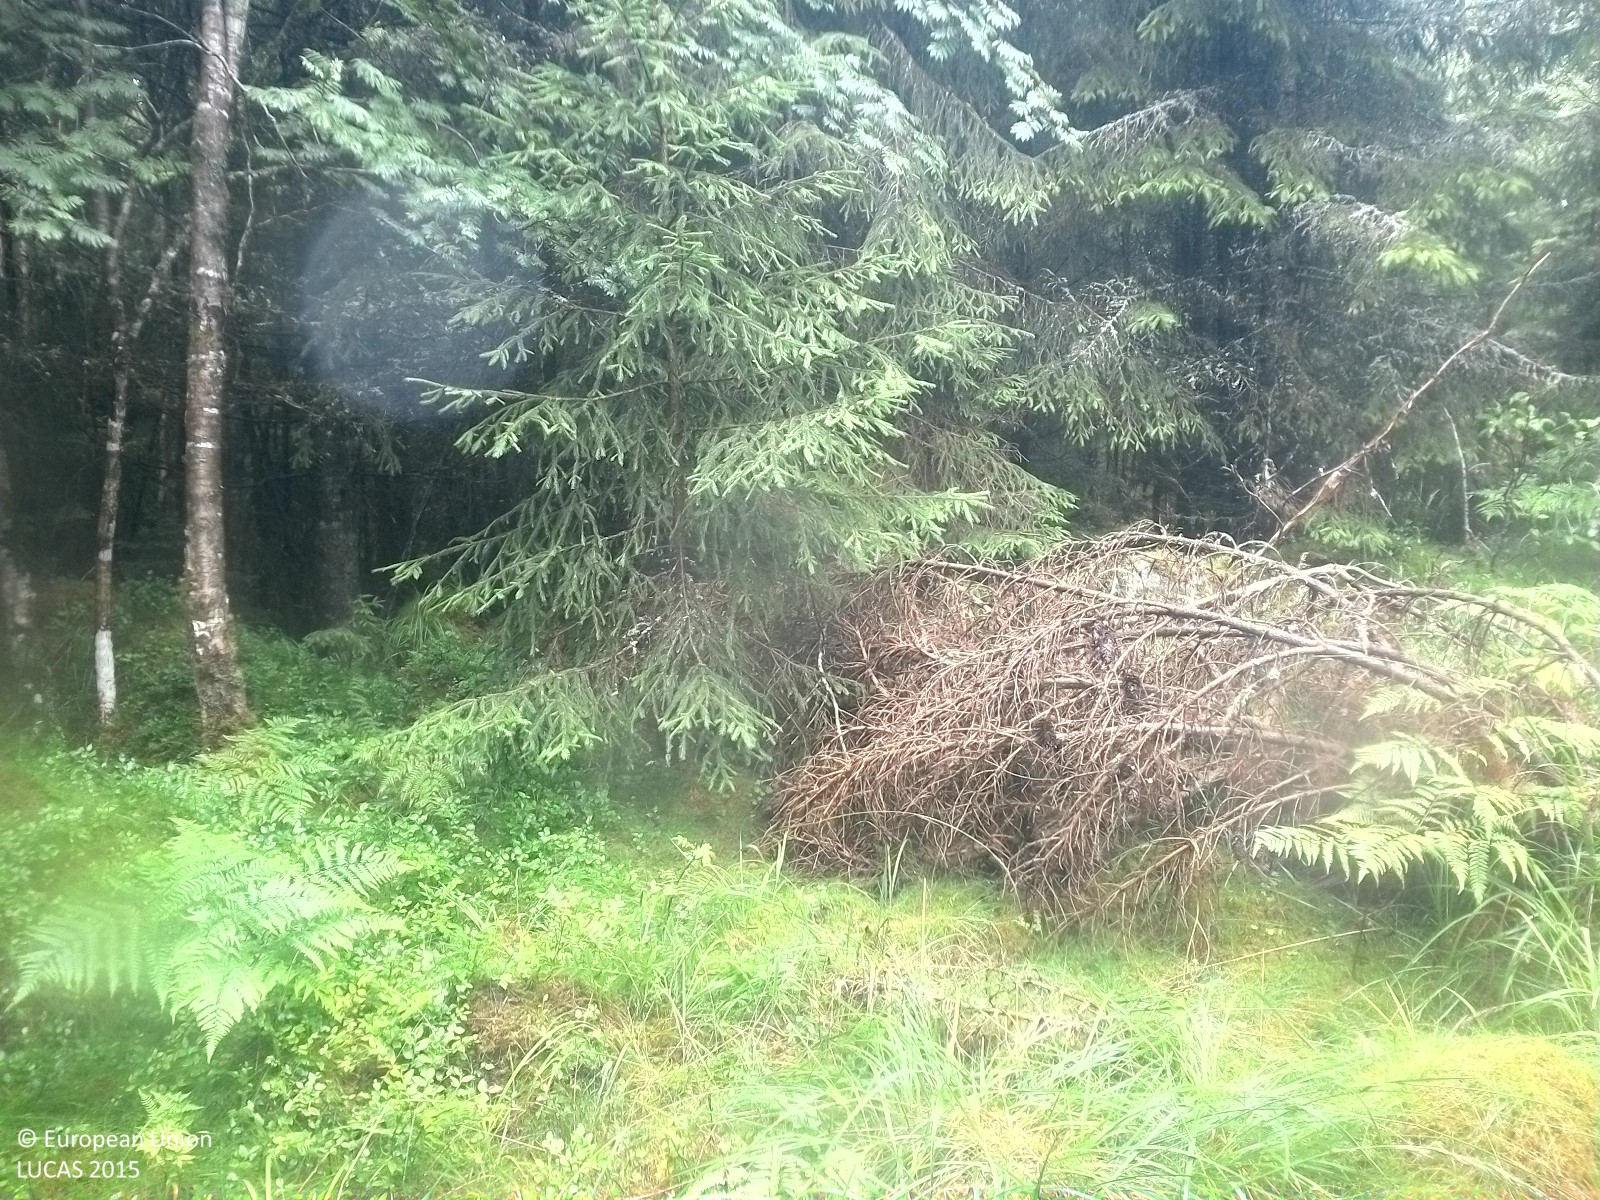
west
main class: Woodland
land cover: Spruce dominated mixed woodland
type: boreal forest
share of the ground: 25 - 50 %
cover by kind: herbaceous plants 55 %, coniferous forest trees 20 %, broadleaved forest trees 15 %, lichens and mosses 10 %
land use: Forestry
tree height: > 5 m
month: July
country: SE
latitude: 58.8463
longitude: 15.0359
